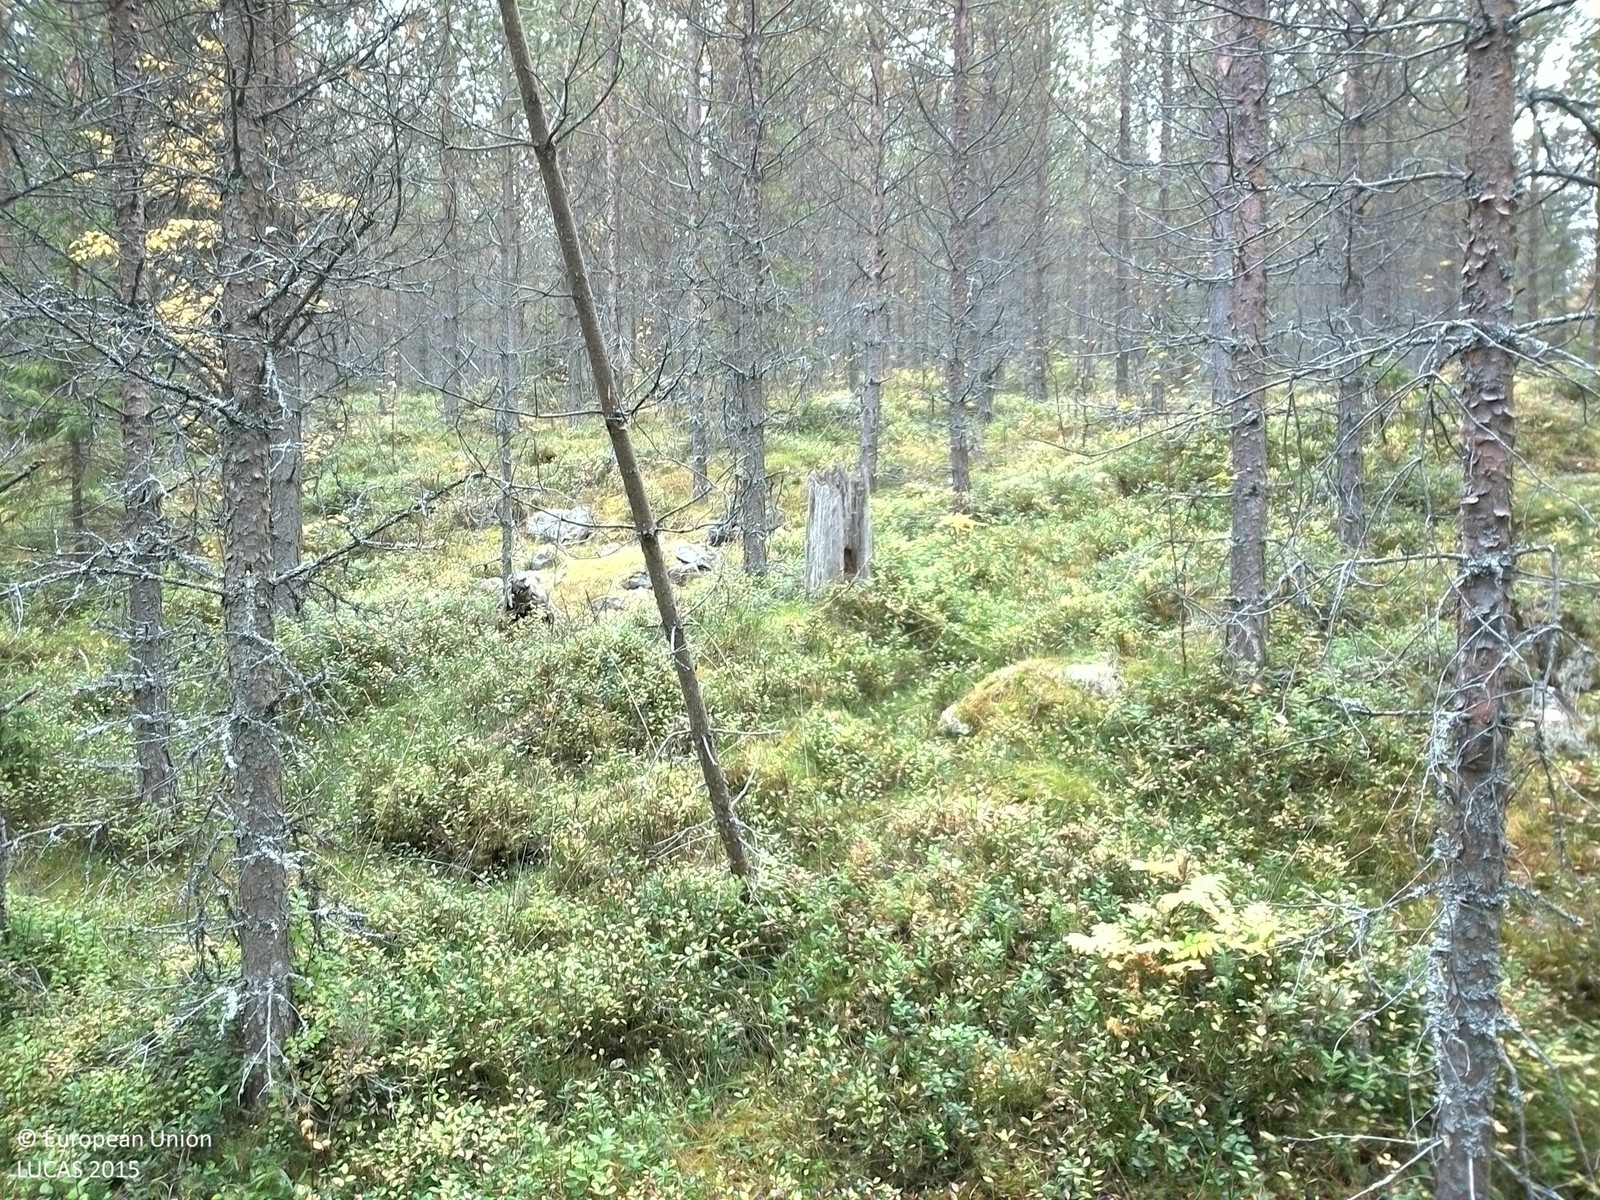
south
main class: Woodland
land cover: Pine dominated coniferous woodland
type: boreal forest
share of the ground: > 75 %
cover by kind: coniferous forest trees 75 %, shrubs 20 %, lichens and mosses 5 %
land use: Forestry
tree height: > 5 m
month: October
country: SE
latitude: 61.4317
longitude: 14.8774
